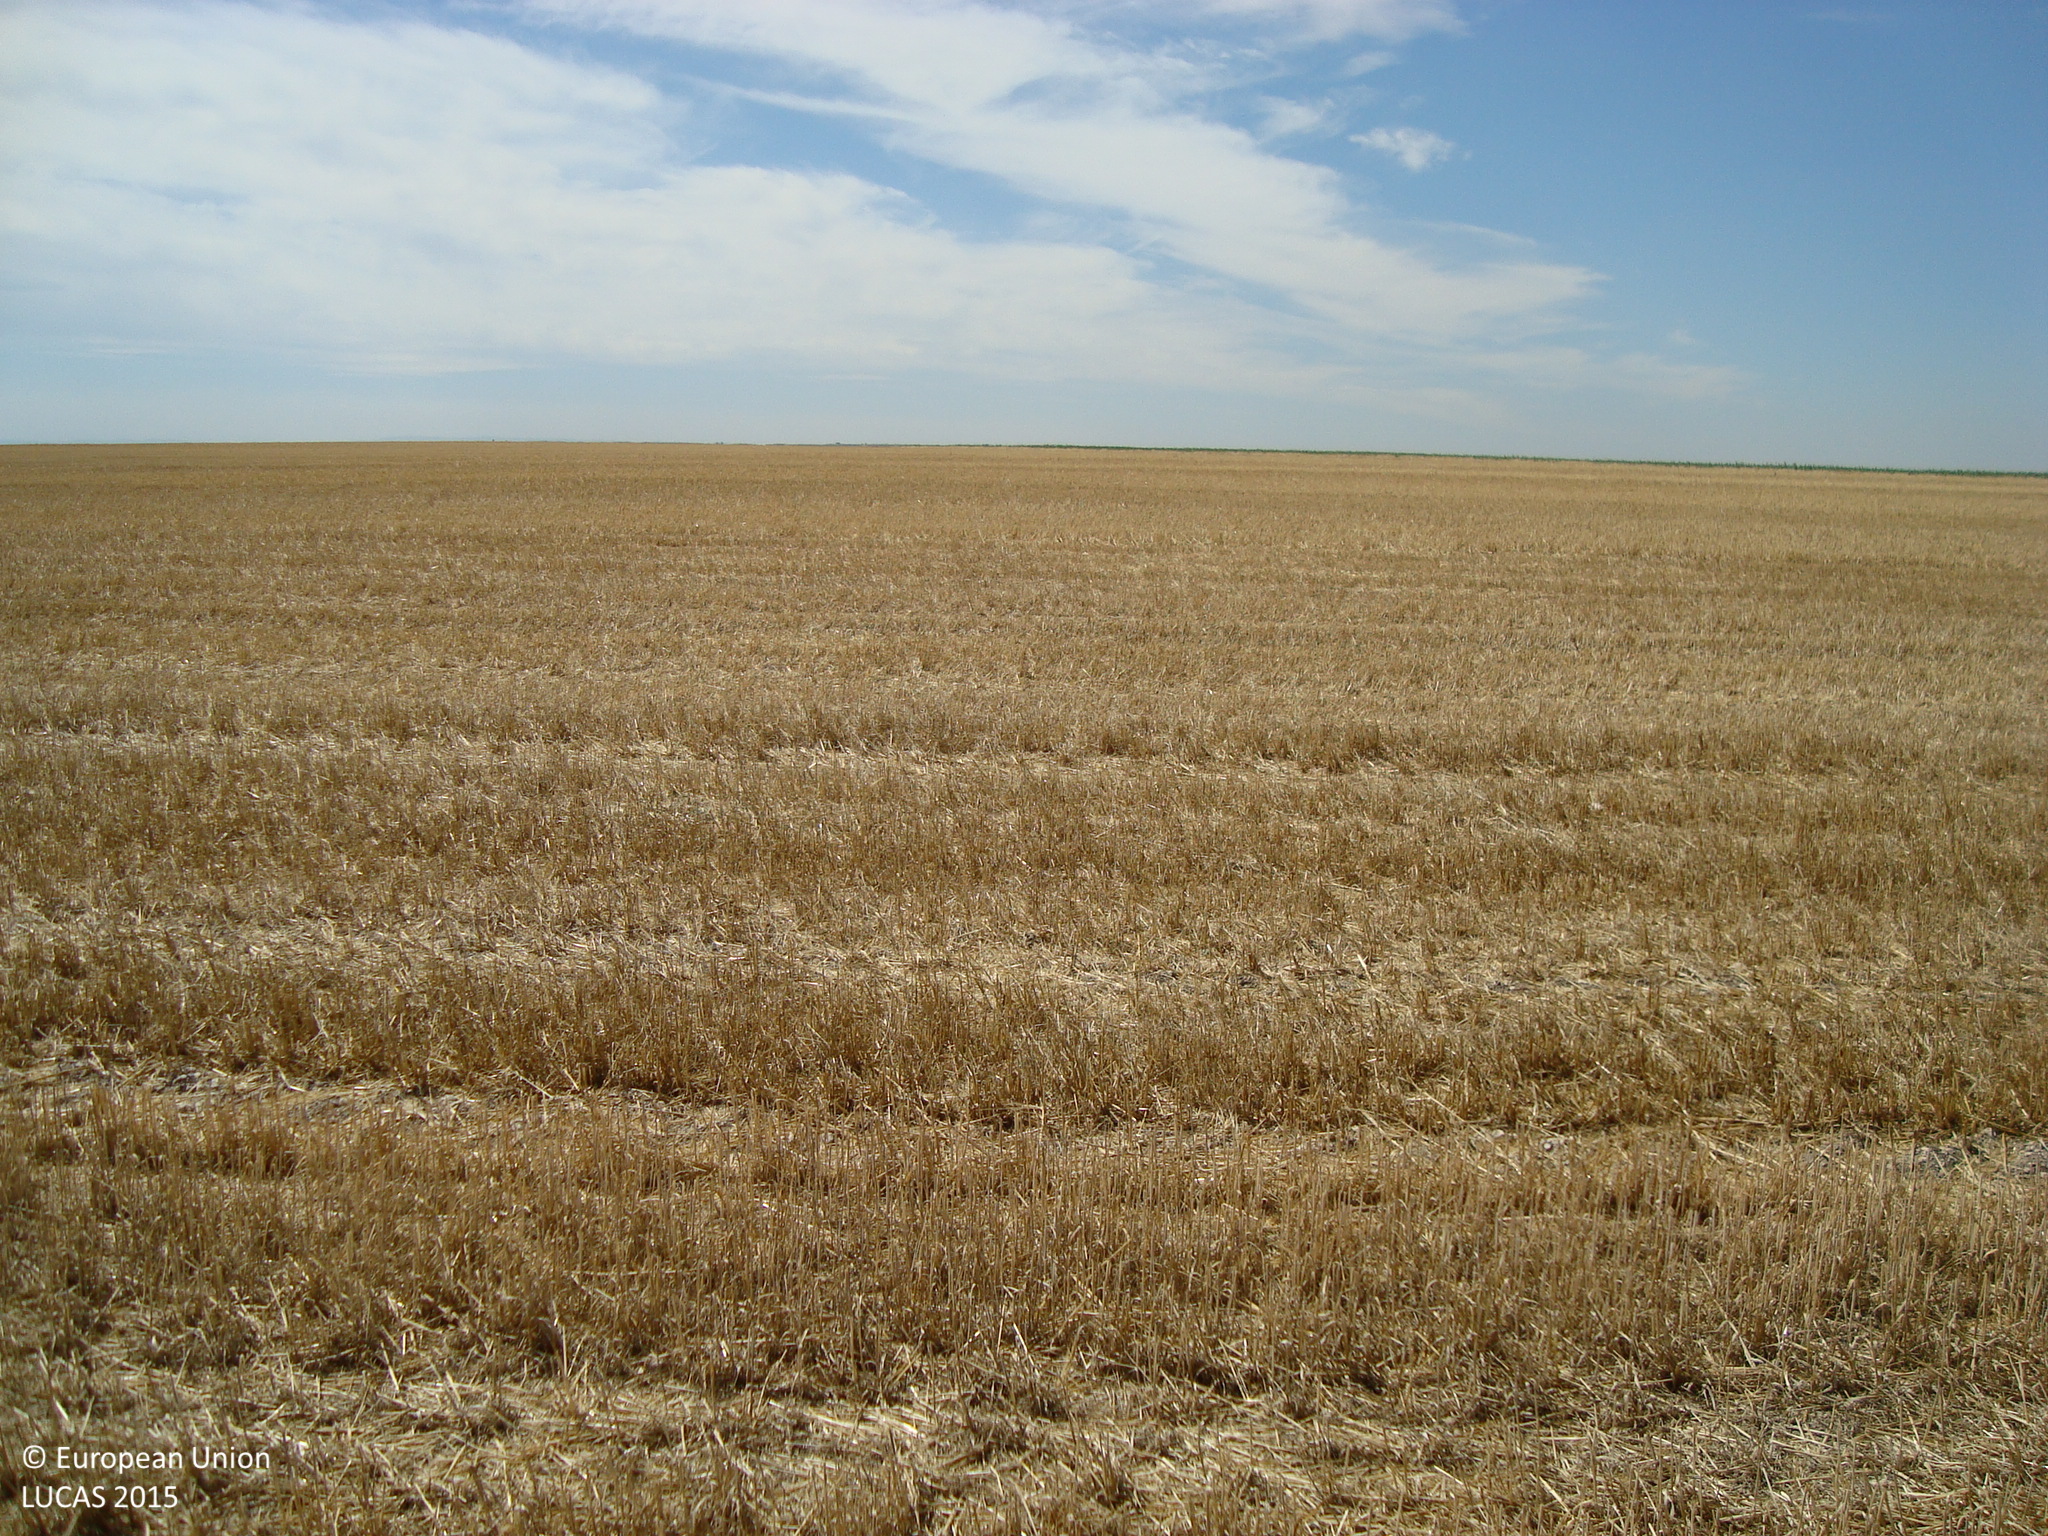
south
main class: Cropland
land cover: Barley
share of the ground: > 75 %
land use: Agriculture (excluding fallow land and kitchen gardens)
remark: Harvested field
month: July
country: ES
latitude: 41.8619
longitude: -3.8510
